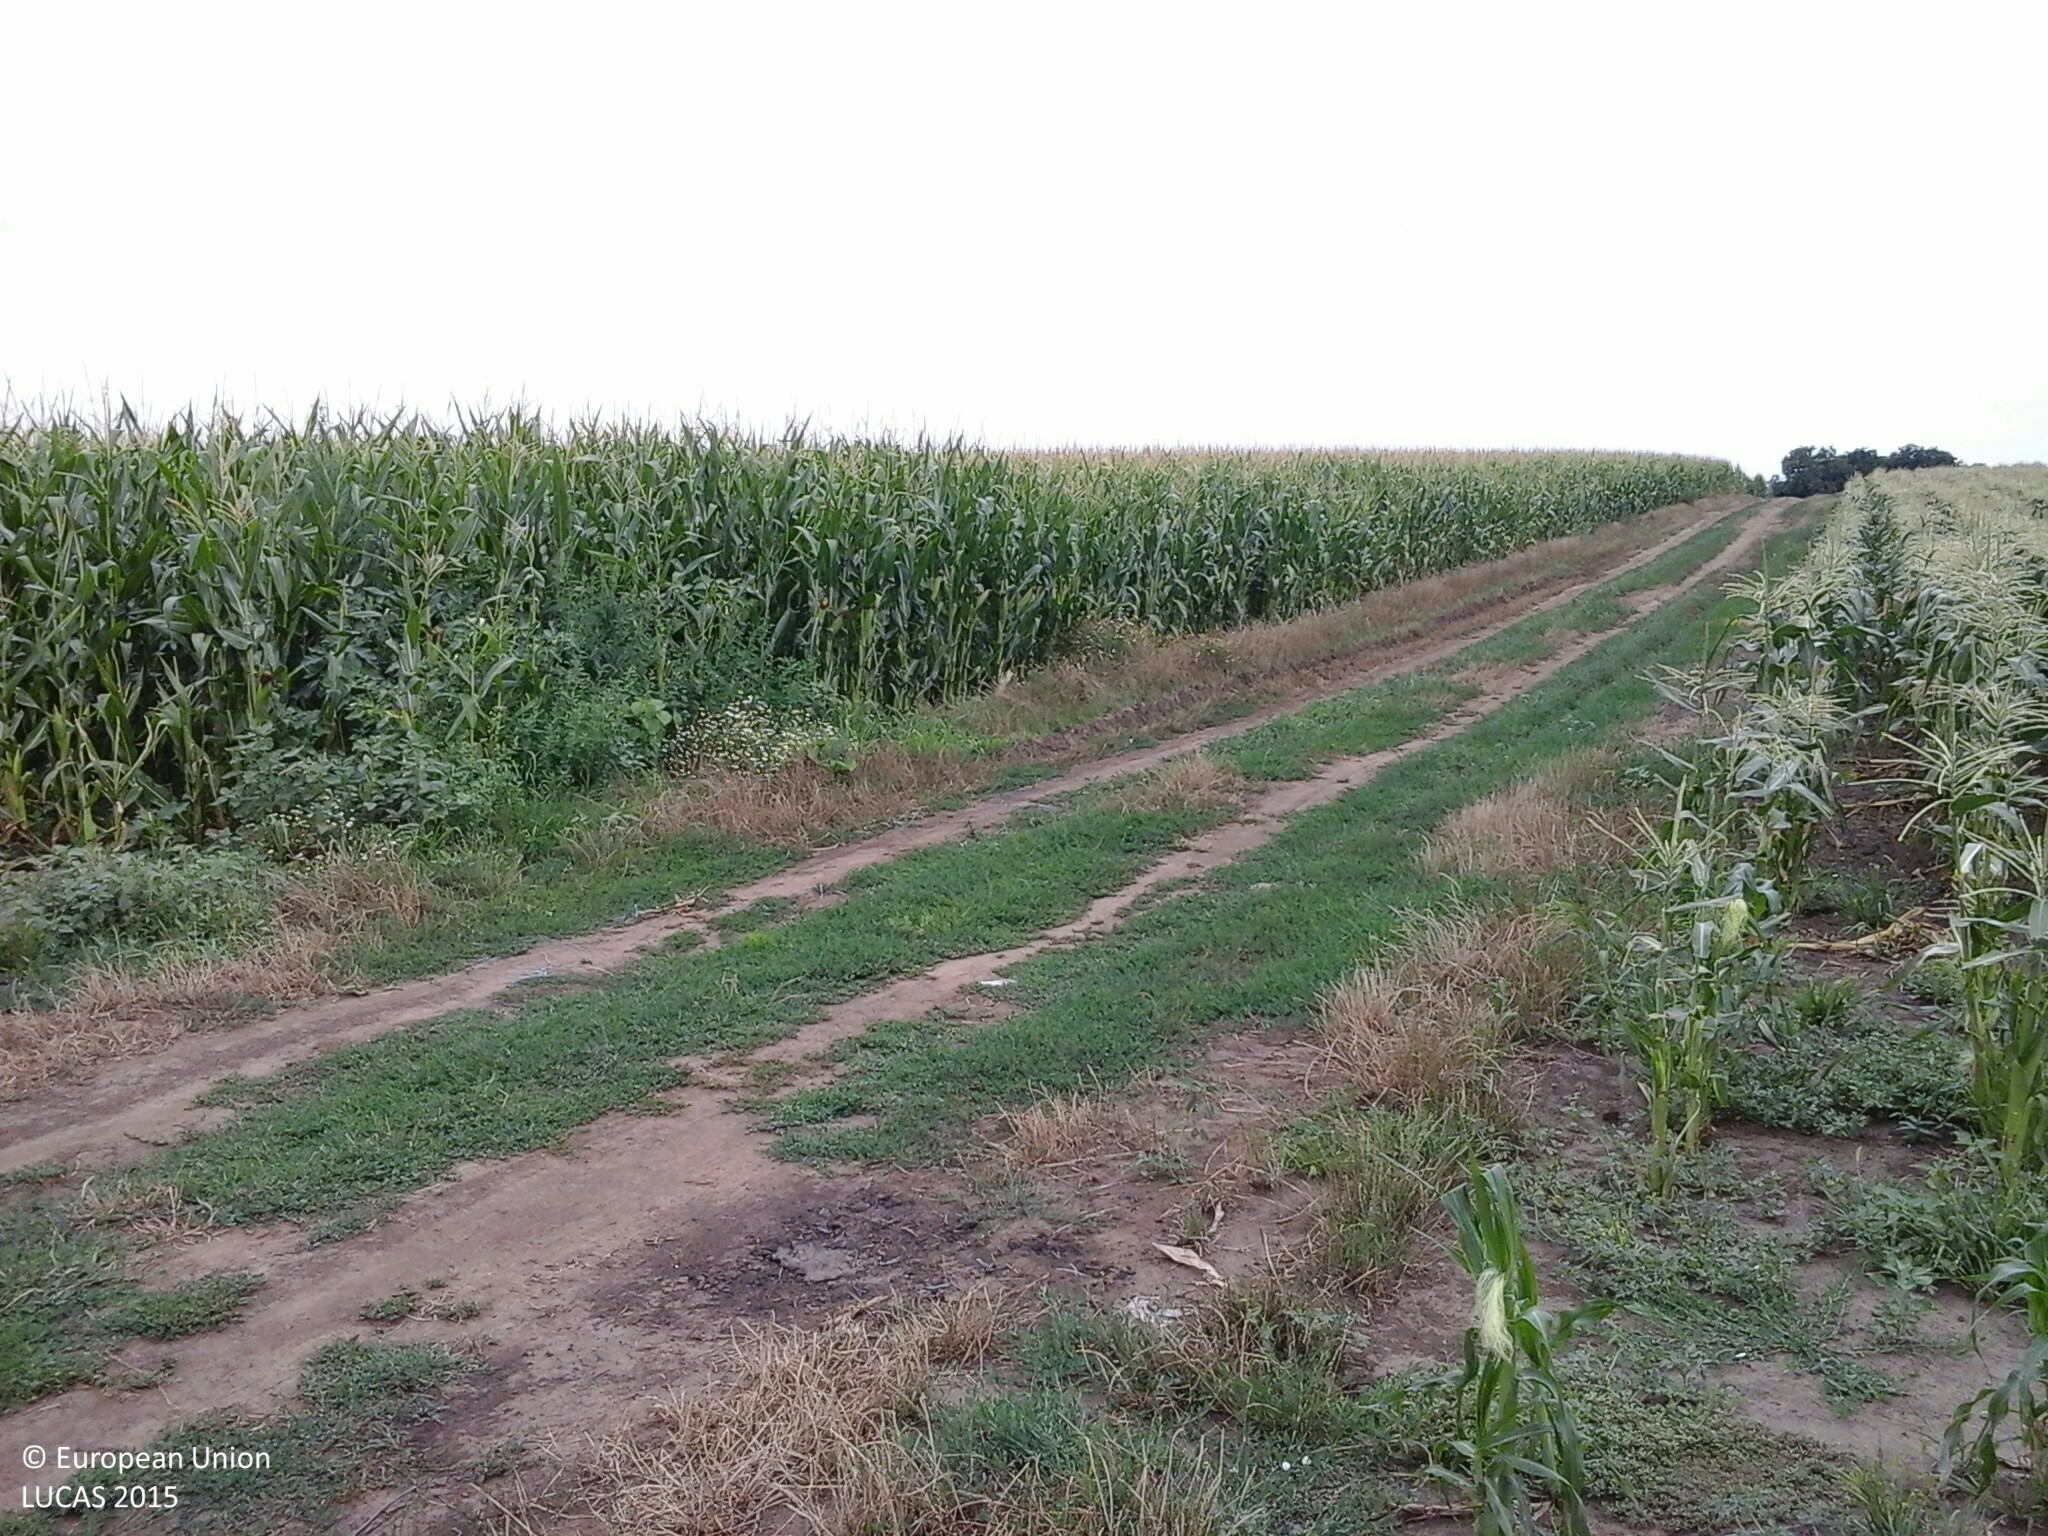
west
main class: Cropland
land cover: Maize
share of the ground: > 75 %
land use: Agriculture (excluding fallow land and kitchen gardens)
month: July
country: HU
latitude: 47.8054
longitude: 21.4602
